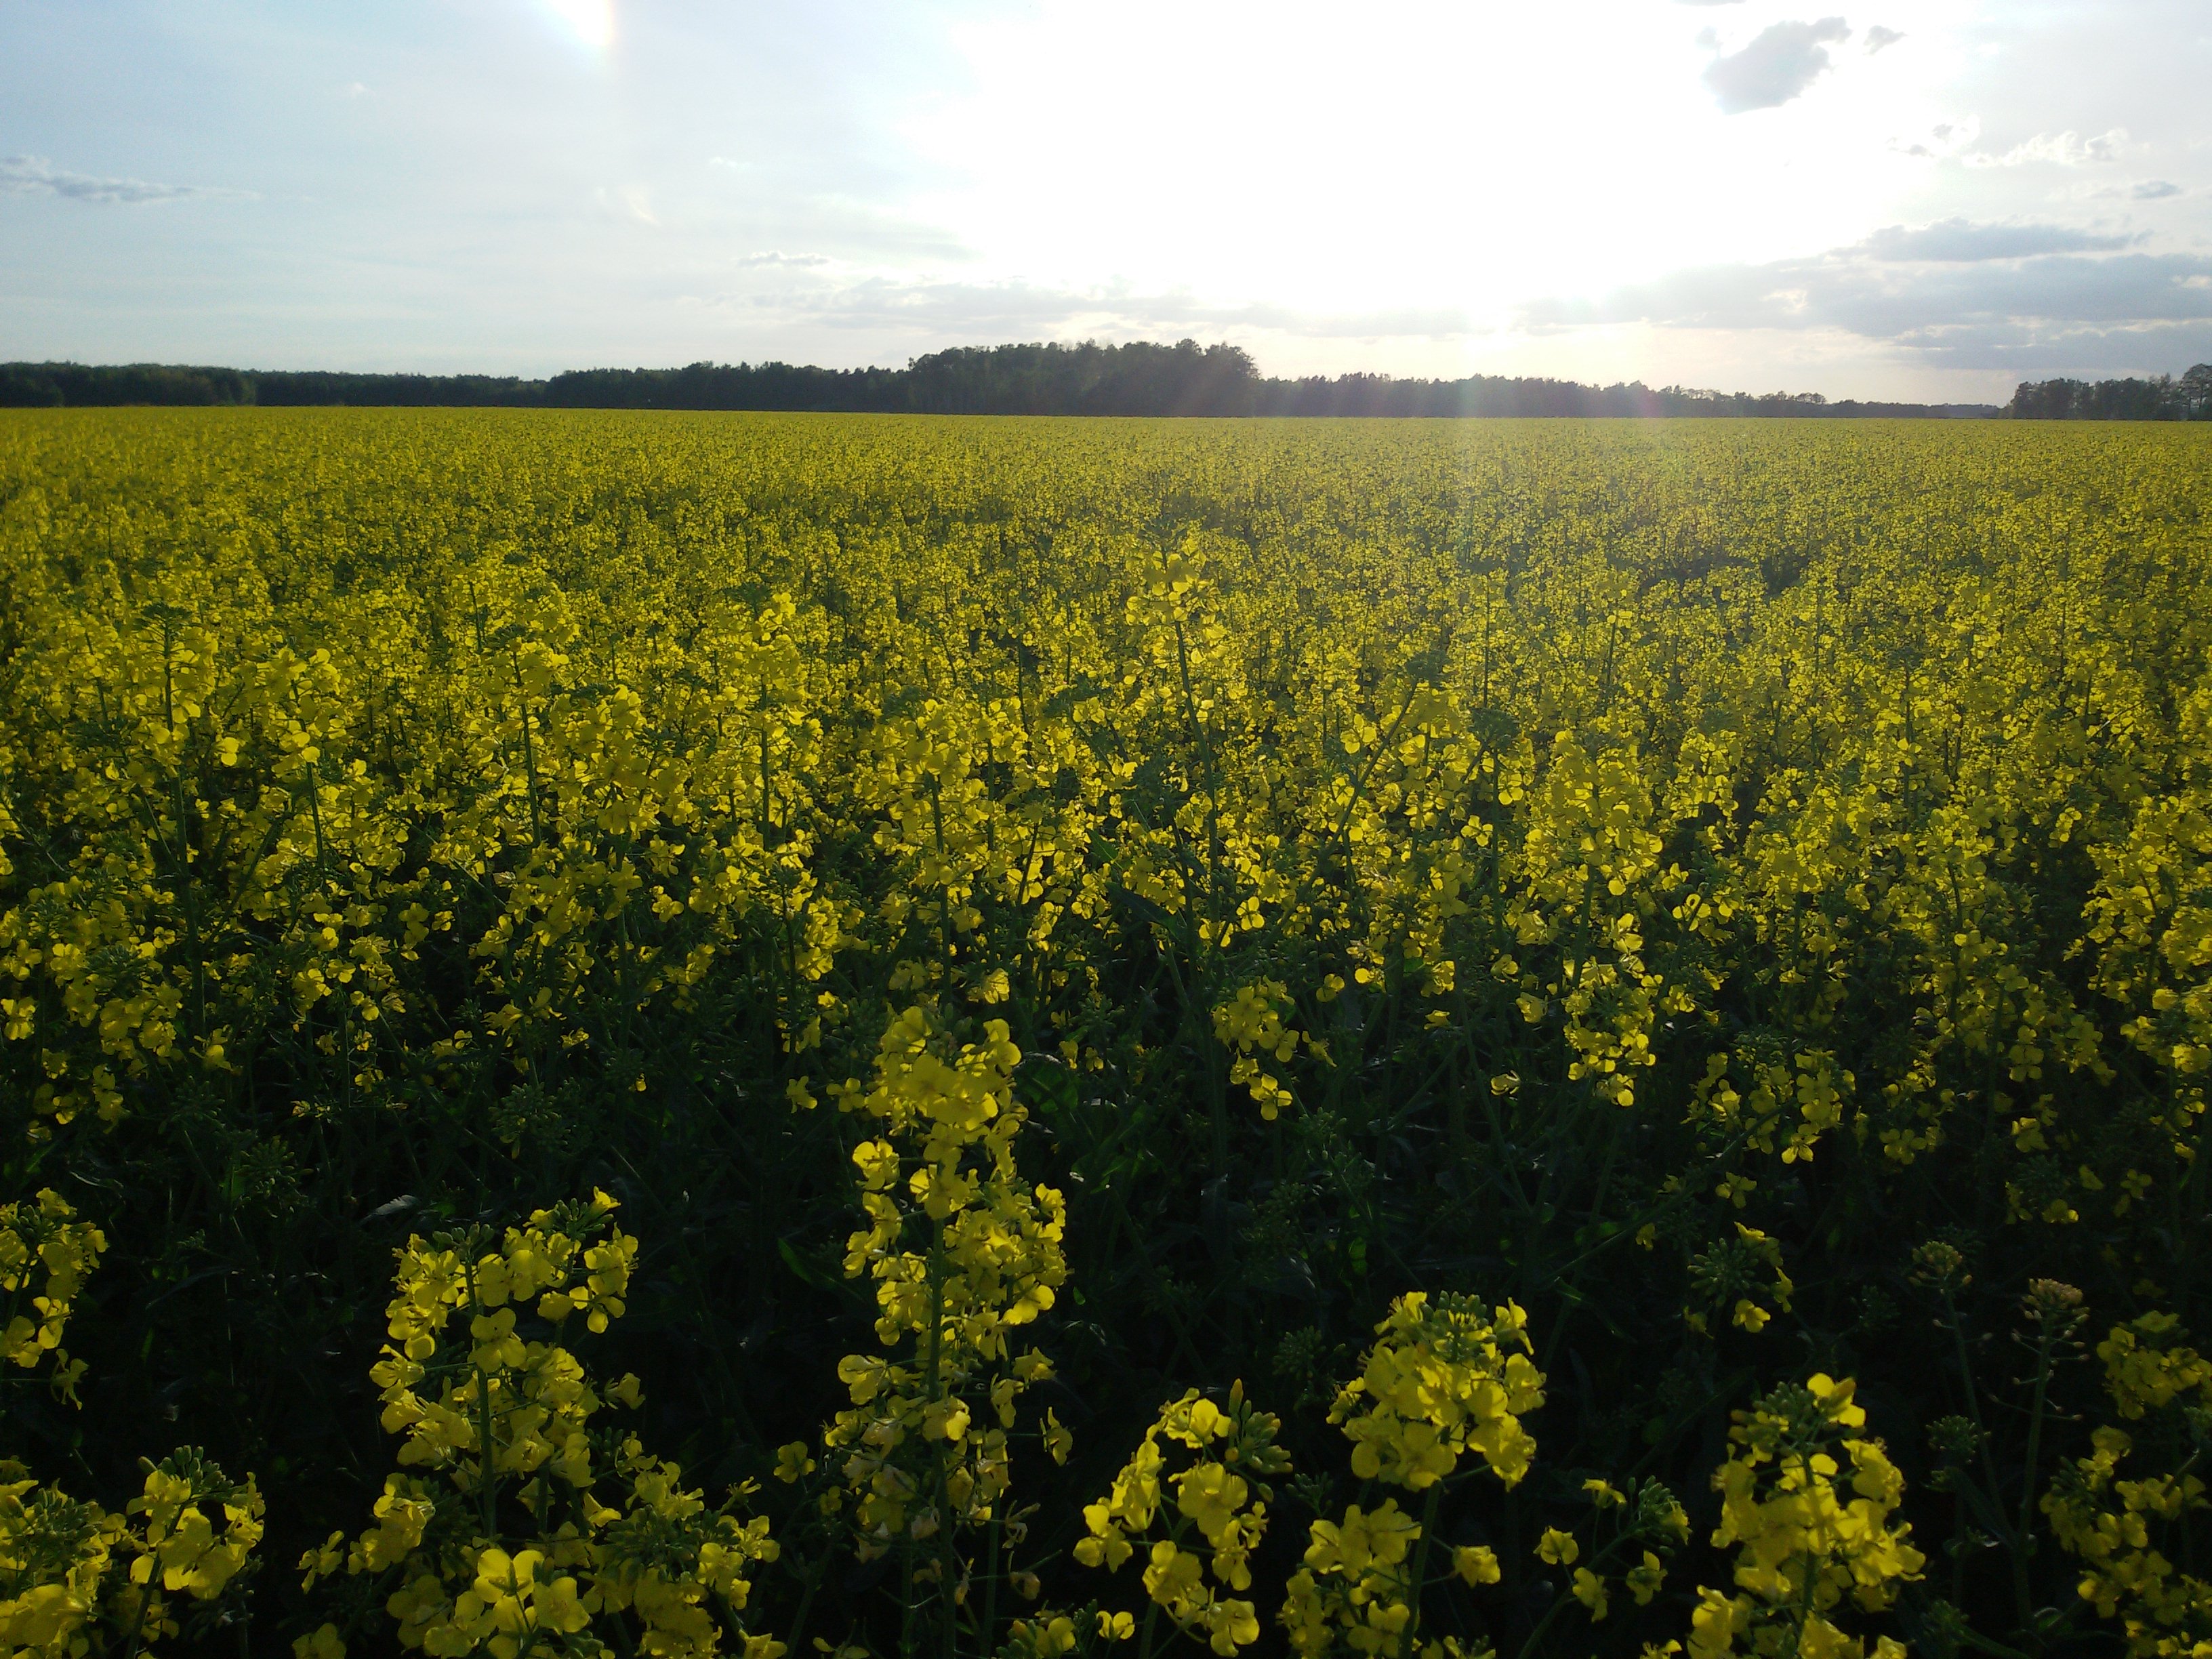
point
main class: Cropland
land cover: Rape and turnip rape
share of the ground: > 75 %
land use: Agriculture (excluding fallow land and kitchen gardens)
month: May
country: PL
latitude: 52.8935
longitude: 22.3562
